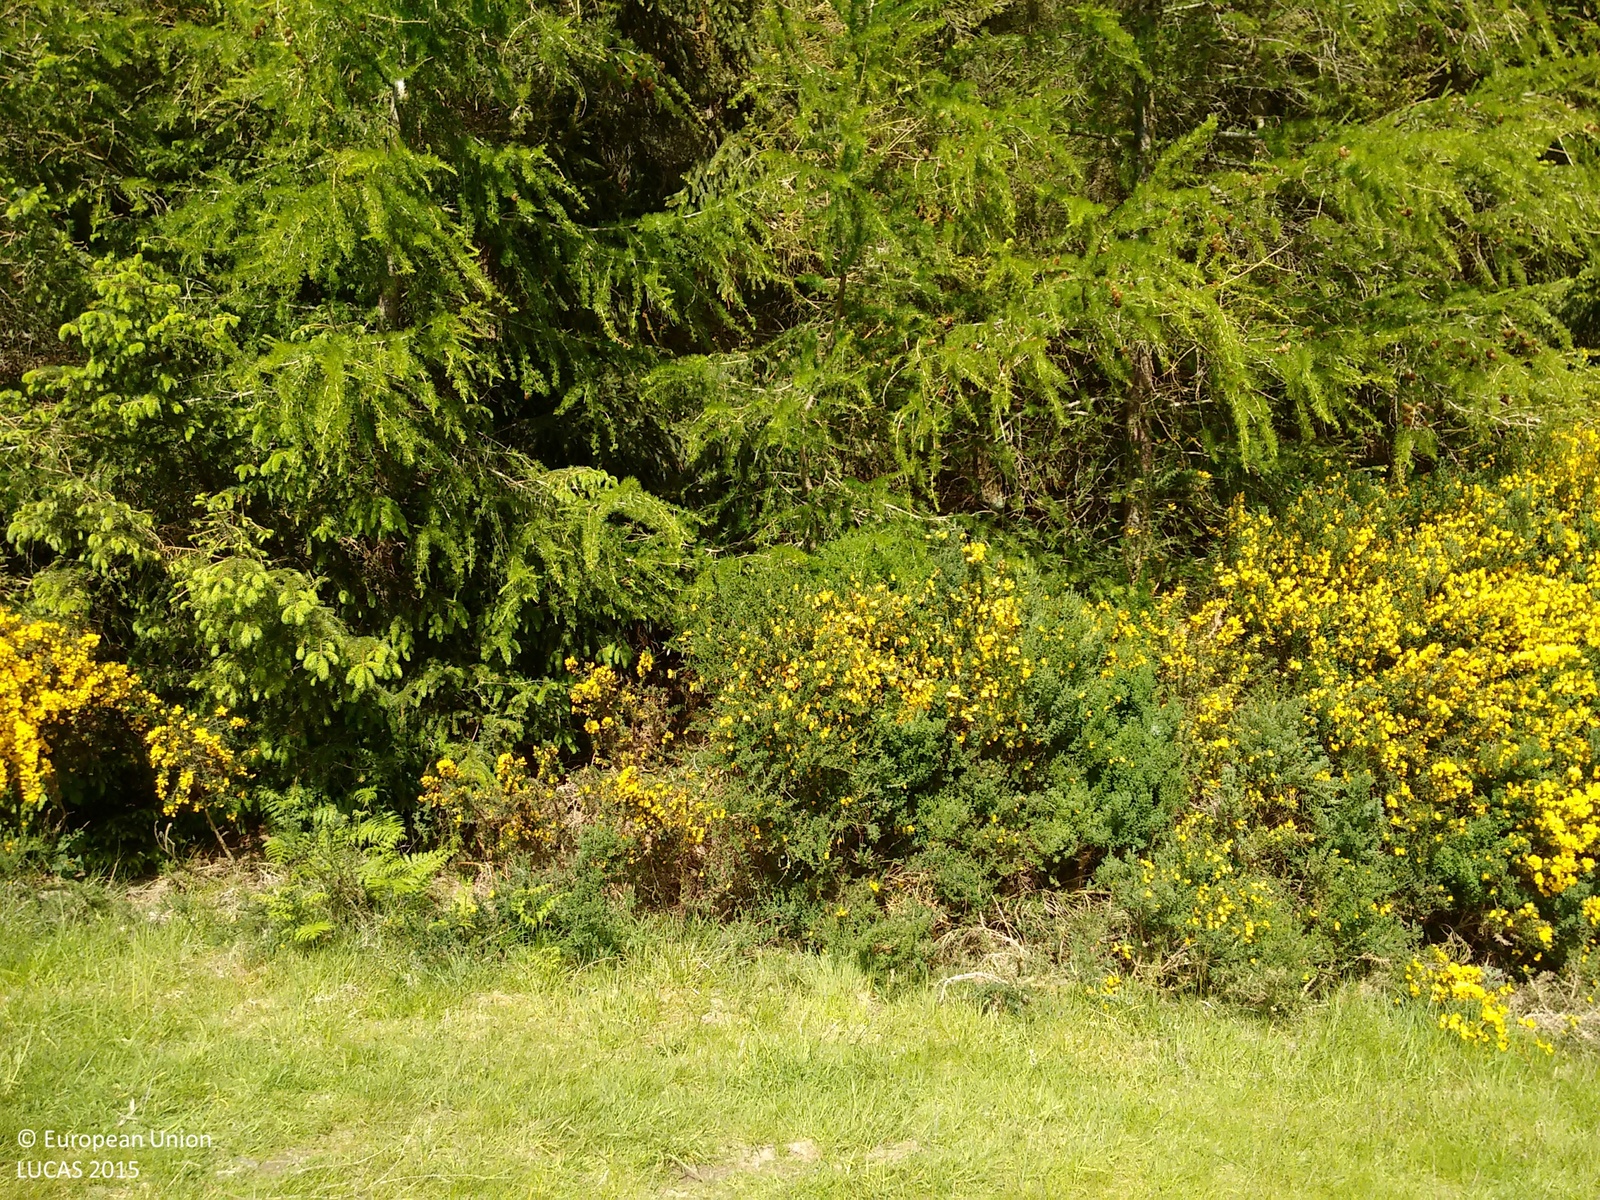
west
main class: Grassland
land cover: Grassland without tree/shrub cover
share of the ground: > 75 %
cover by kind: herbaceous plants 100 %
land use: Agriculture (excluding fallow land and kitchen gardens)
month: June
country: GB
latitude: 55.5325
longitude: -2.1761
